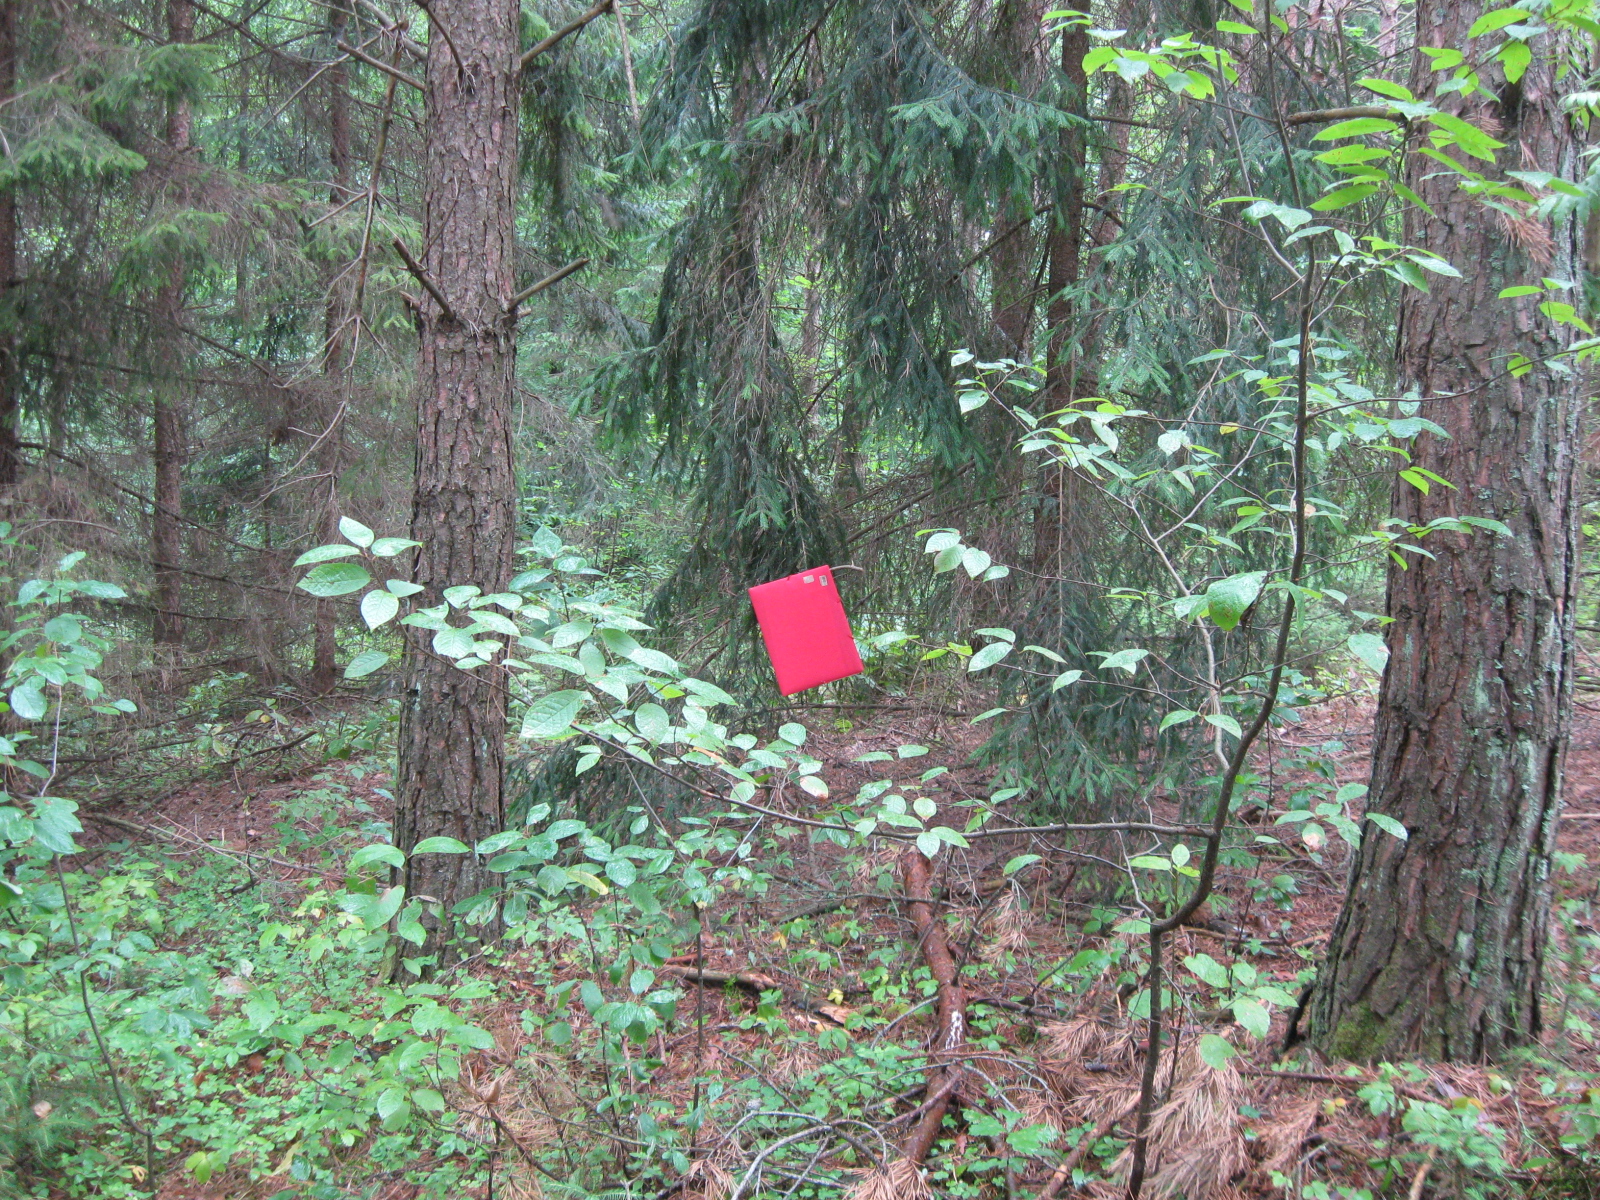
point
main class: Woodland
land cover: Pine dominated coniferous woodland
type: hemiboreal forest and nemoral coniferous forest and mixed broadleaved-coniferous forest
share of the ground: > 75 %
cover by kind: coniferous forest trees 90 %, broadleaved forest trees 5 %, herbaceous plants 5 %
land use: Forestry
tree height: > 5 m
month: July
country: LT
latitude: 54.2864
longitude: 24.2770
